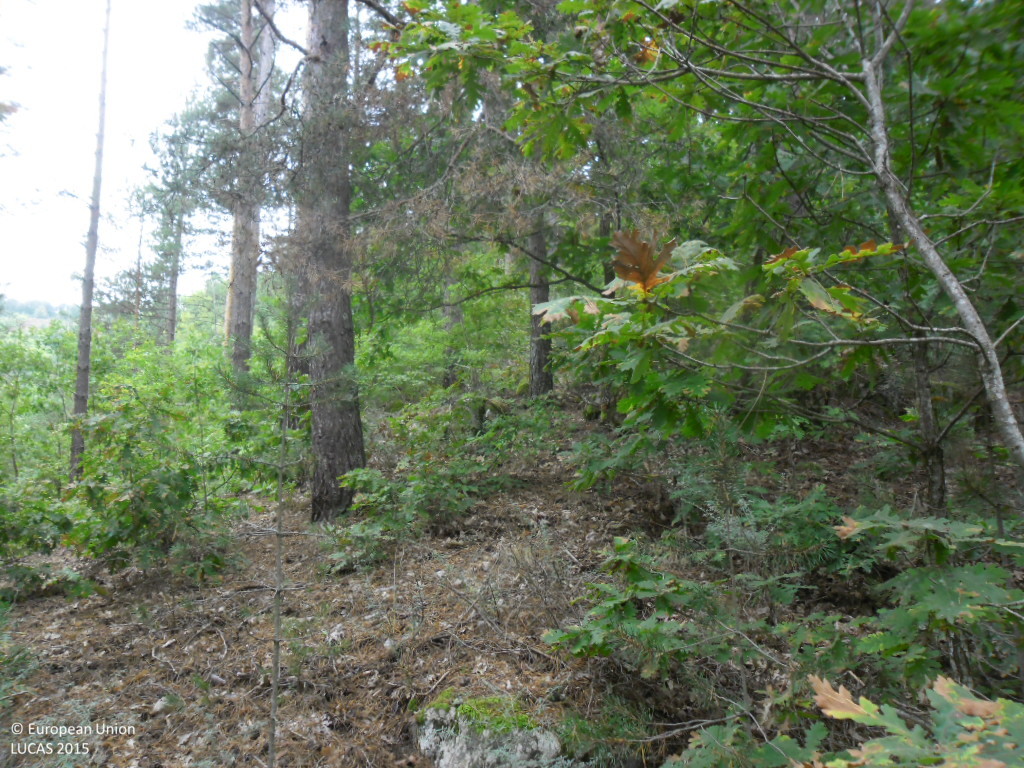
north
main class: Woodland
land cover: Pine dominated coniferous woodland
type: hemiboreal forest and nemoral coniferous forest and mixed broadleaved-coniferous forest
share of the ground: > 75 %
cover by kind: coniferous forest trees 95 %, unconsolidated bare surface 5 %
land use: Forestry
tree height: > 5 m
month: September
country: BG
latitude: 41.6418
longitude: 23.0458
